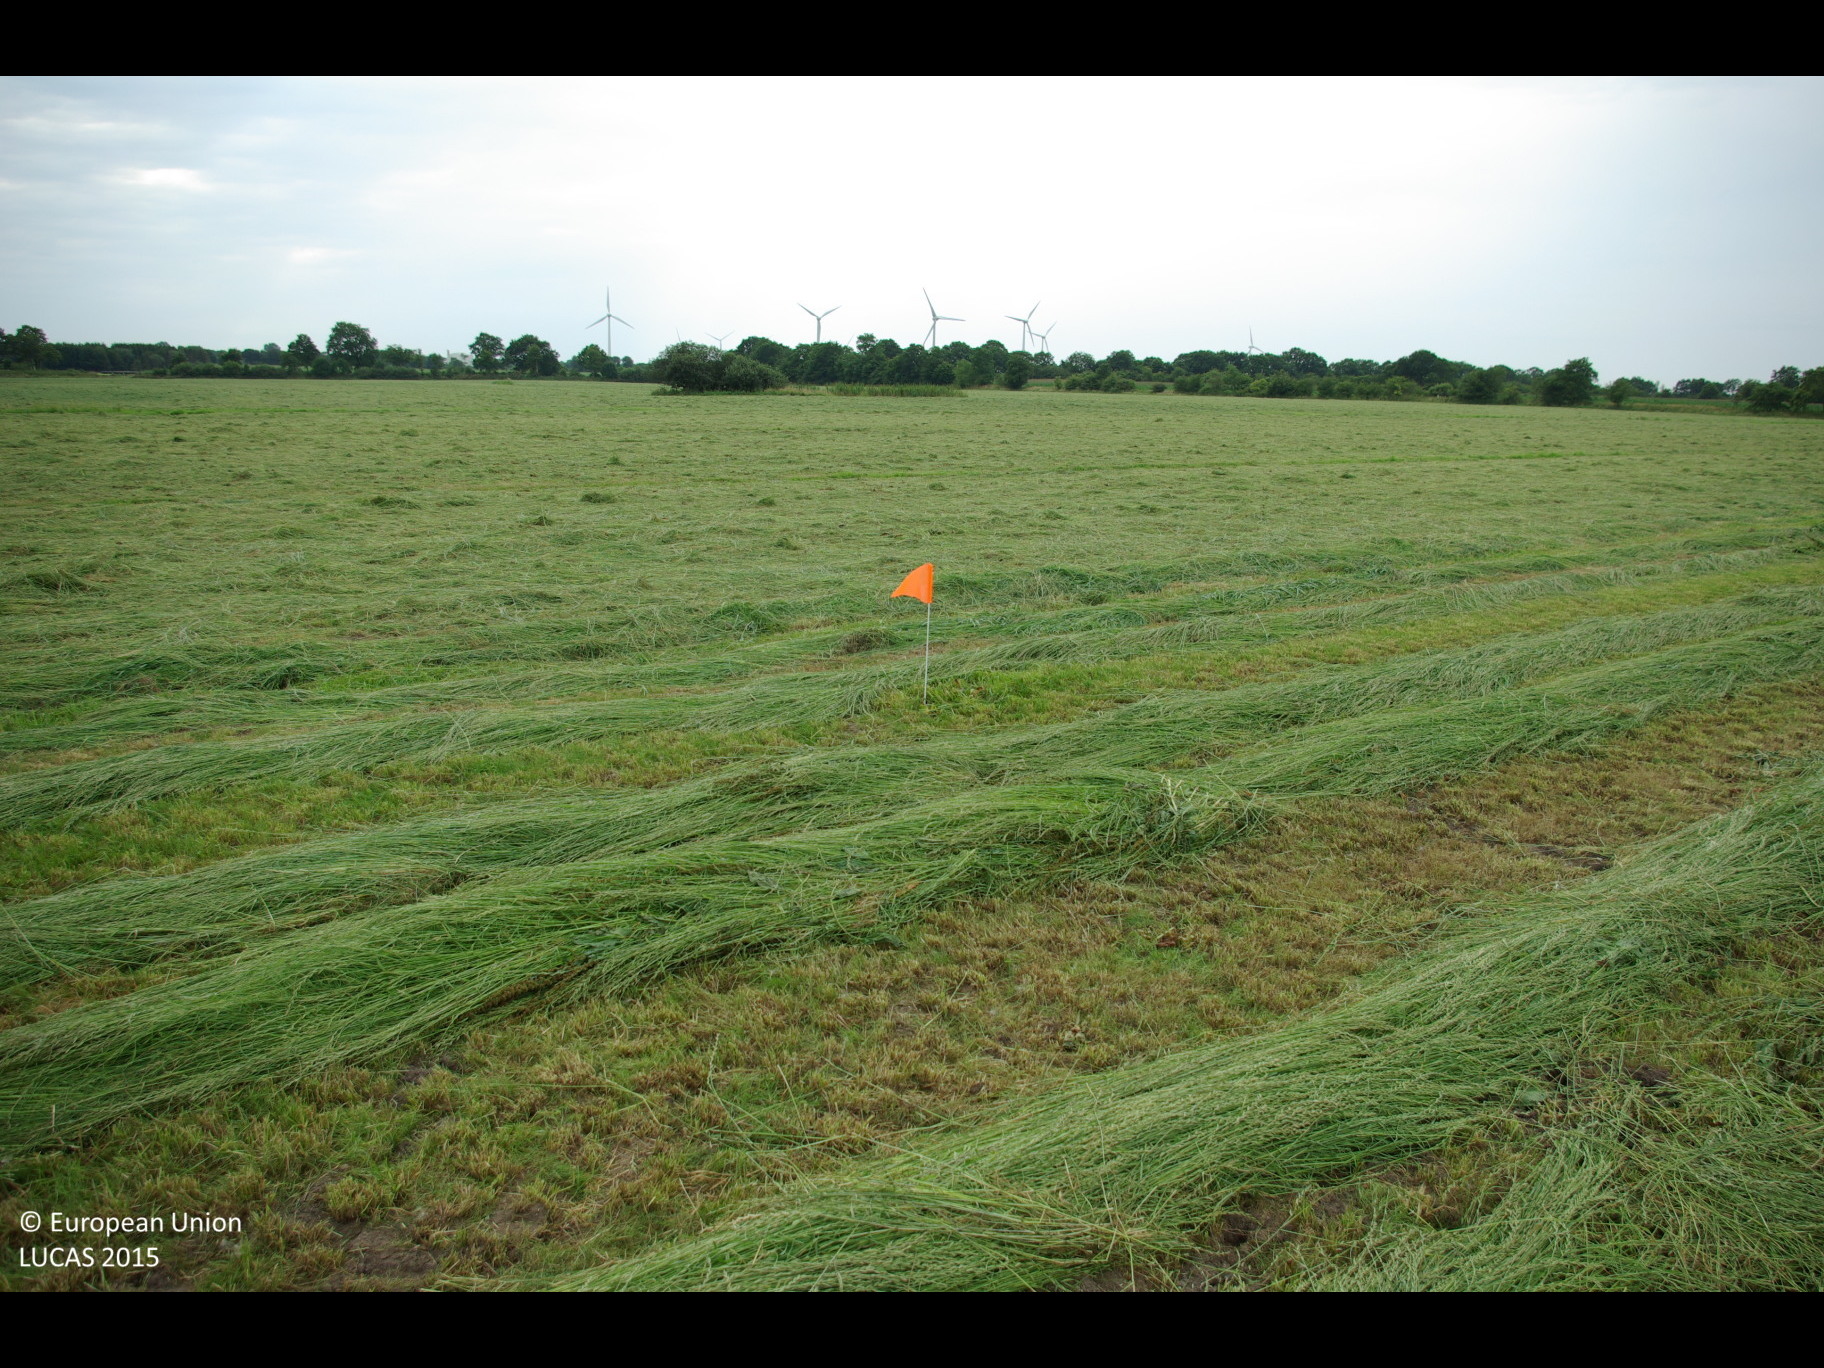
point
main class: Grassland
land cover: Grassland without tree/shrub cover
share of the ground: > 75 %
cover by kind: herbaceous plants 100 %
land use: Agriculture (excluding fallow land and kitchen gardens)
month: August
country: DE
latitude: 54.2799
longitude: 9.1865
